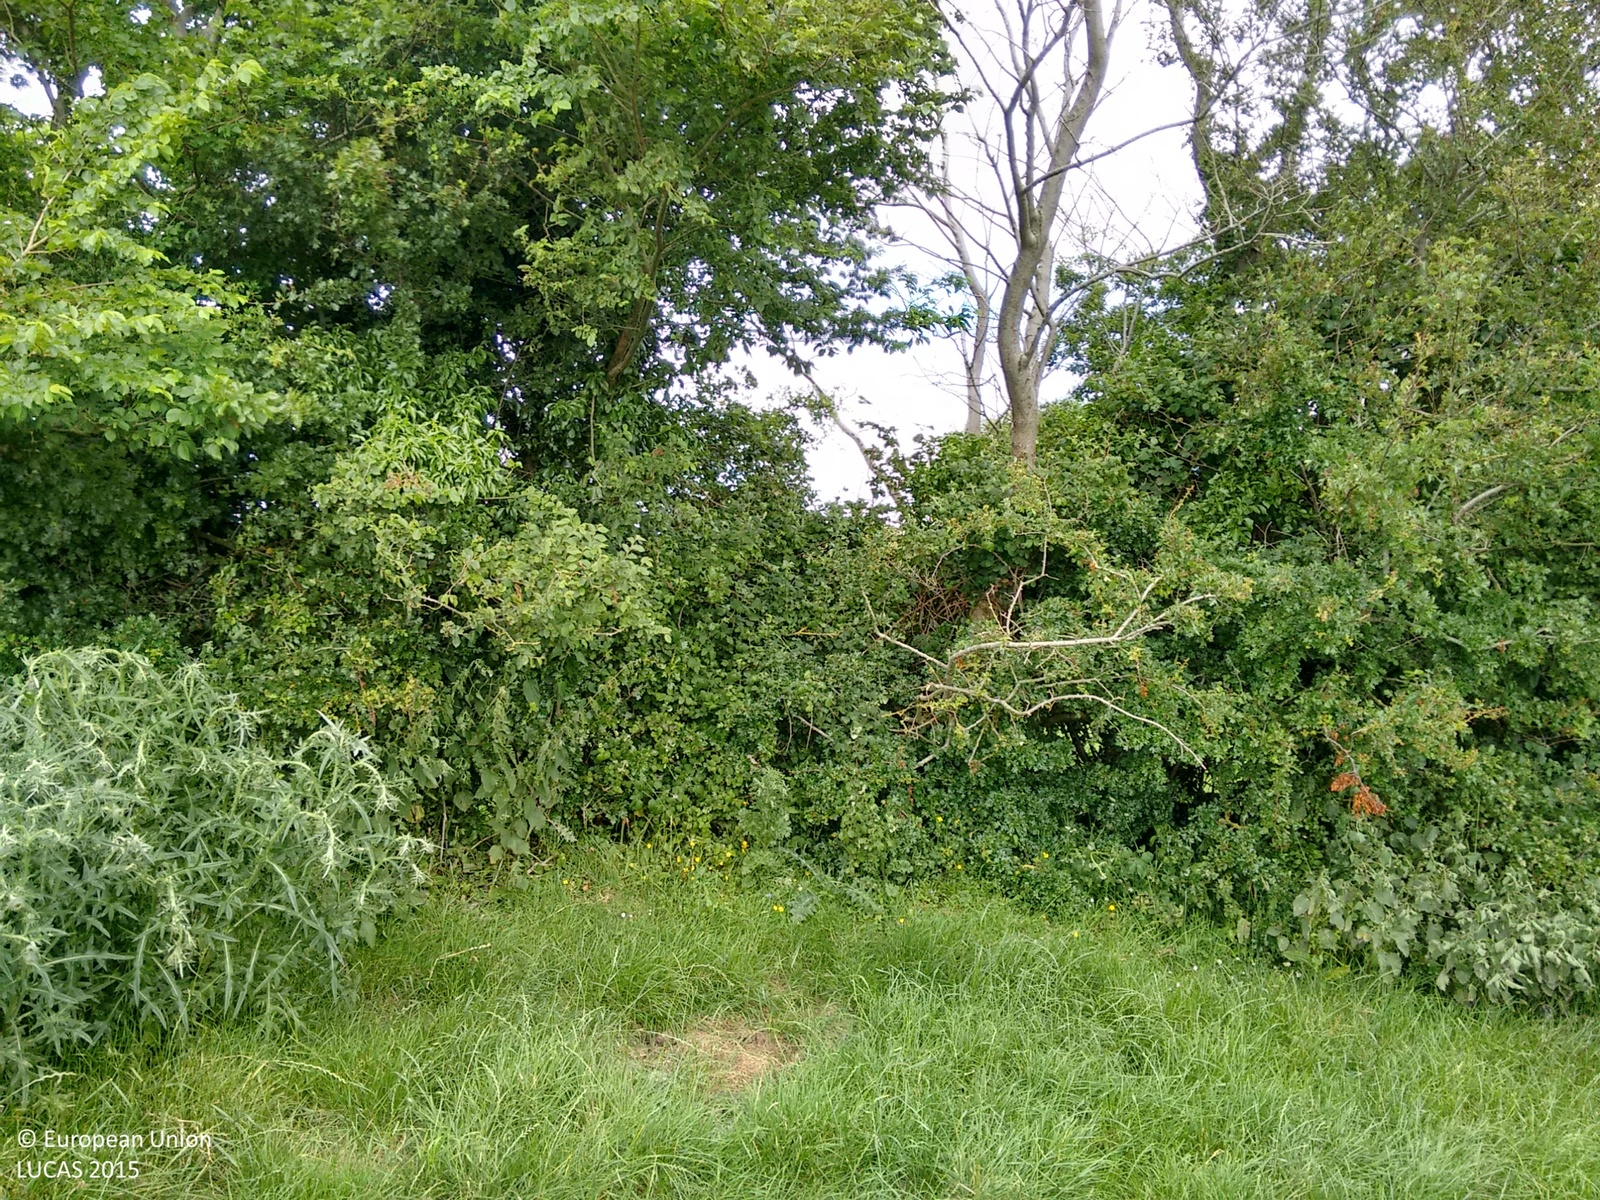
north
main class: Grassland
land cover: Grassland without tree/shrub cover
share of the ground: > 75 %
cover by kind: herbaceous plants 100 %
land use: Agriculture (excluding fallow land and kitchen gardens)
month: July
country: IE
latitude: 53.8719
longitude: -6.6629
